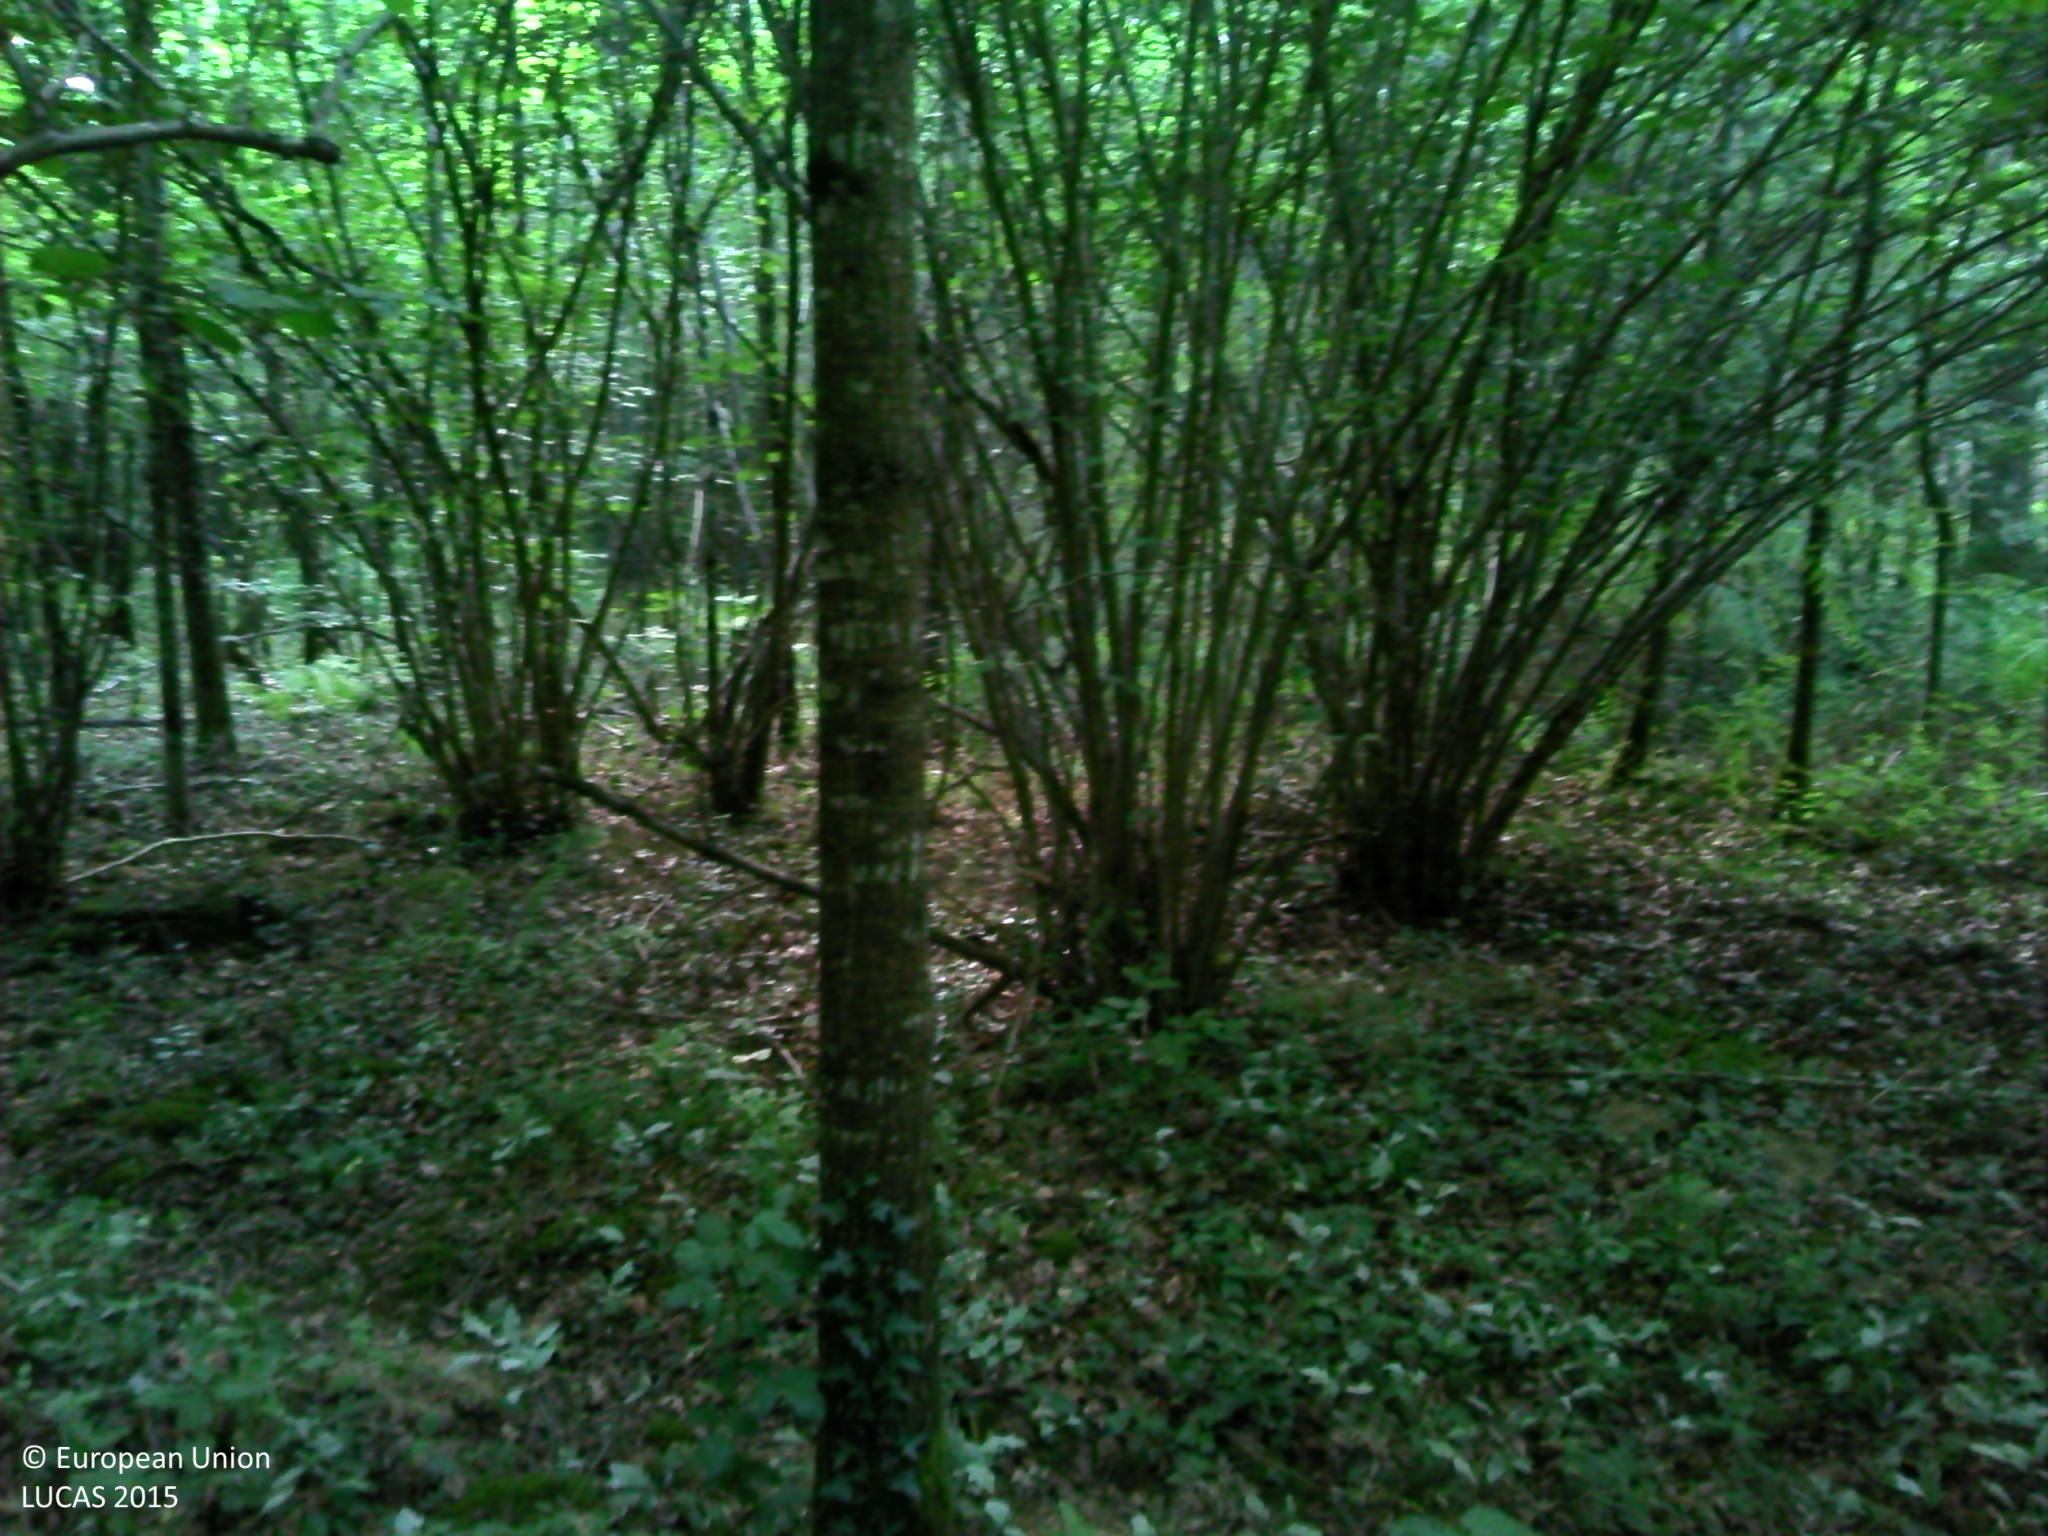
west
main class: Woodland
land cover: Broadleaved woodland
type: acidophilous oak and oak-birch forest
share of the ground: > 75 %
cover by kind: broadleaved forest trees 90 %, shrubs 5 %, herbaceous plants 5 %
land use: Forestry
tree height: > 5 m
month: June
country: FR
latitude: 46.9082
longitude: 0.1179
